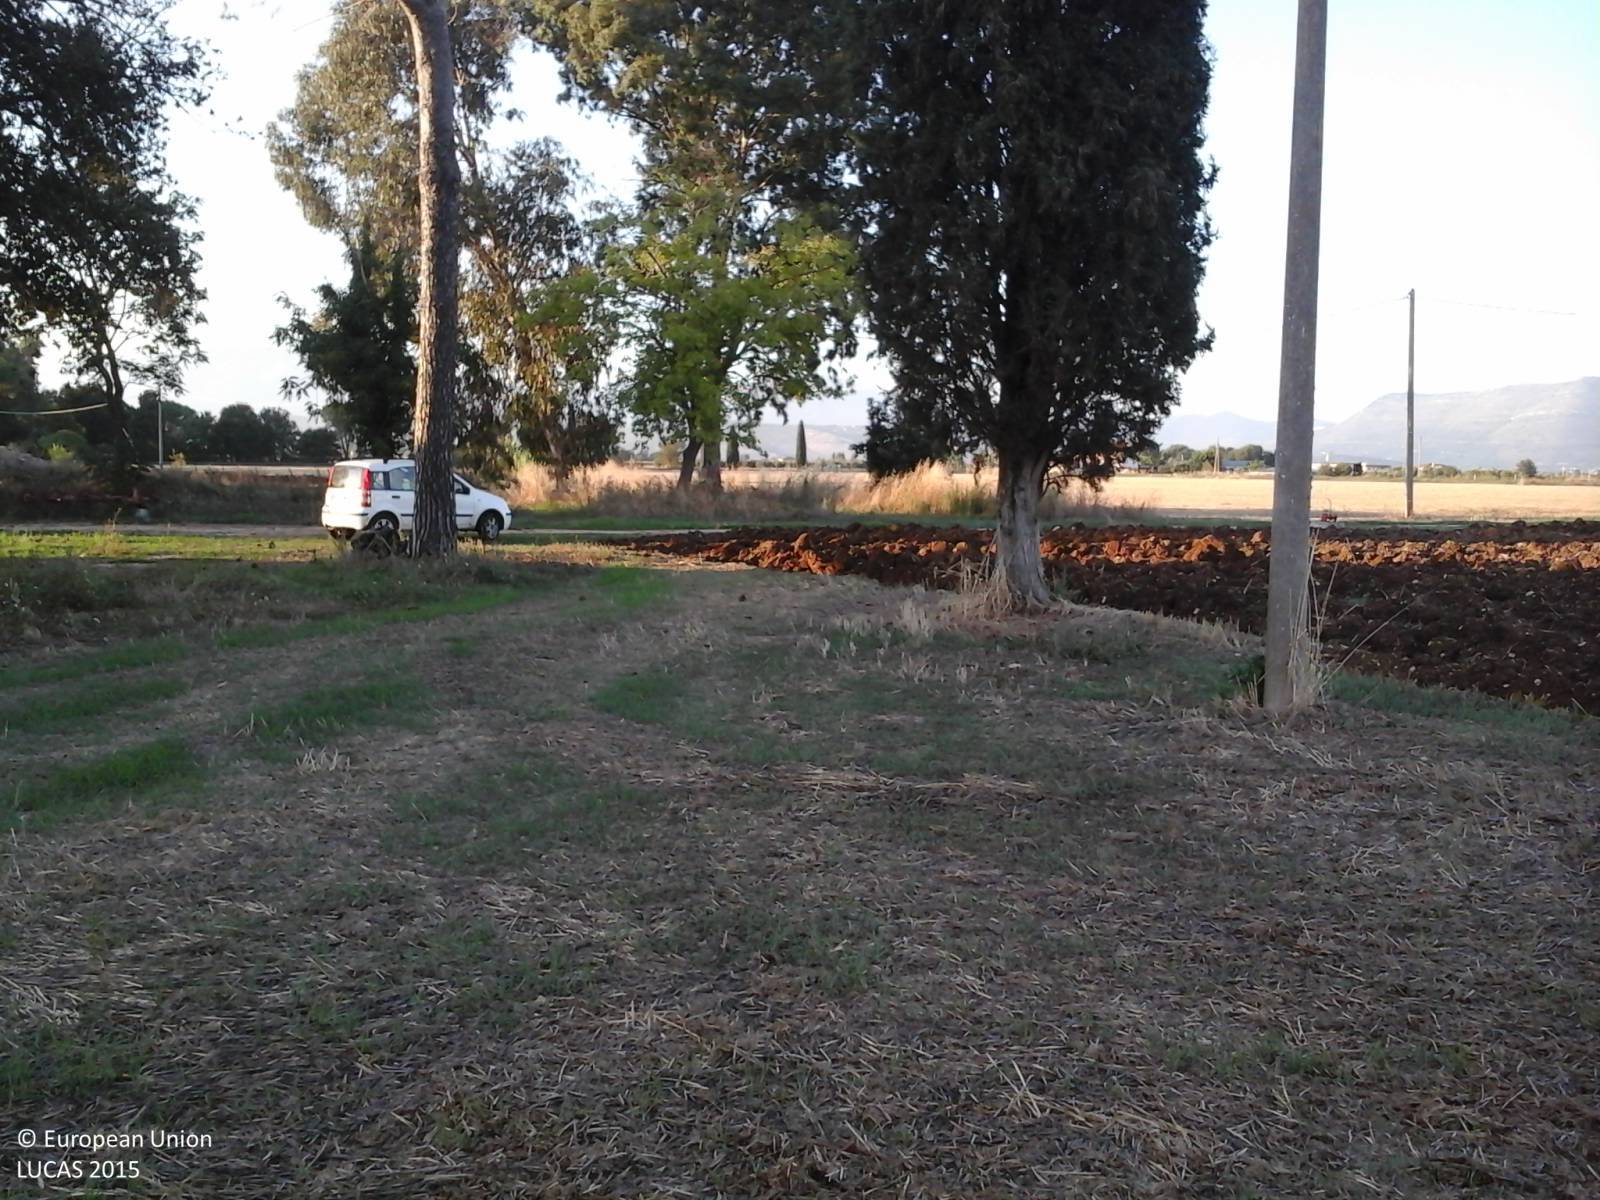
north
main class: Cropland
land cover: Common wheat
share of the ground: < 10 %
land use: Agriculture (excluding fallow land and kitchen gardens)
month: August
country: IT
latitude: 41.3752
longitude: 13.1558
